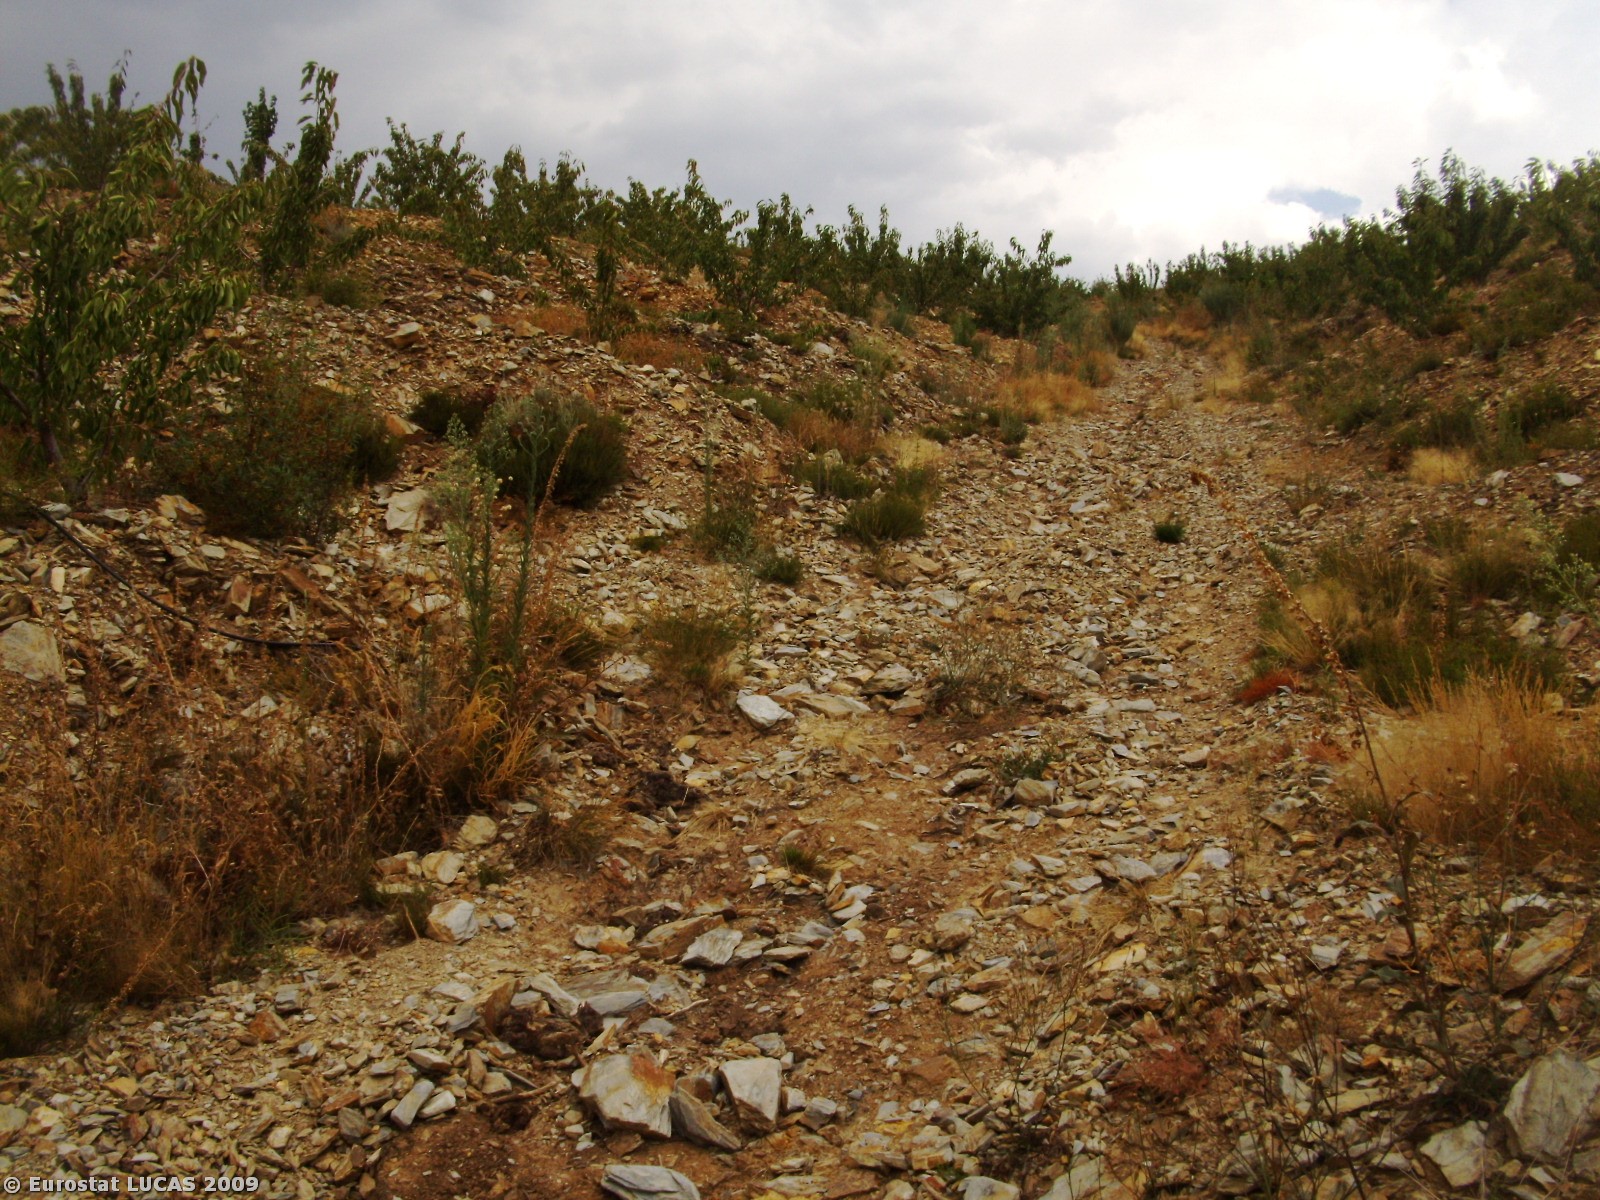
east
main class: Cropland
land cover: Cherry fruit
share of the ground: 25 - 50 %
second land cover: Bare land
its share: > 75 %
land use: Agriculture (excluding fallow land and kitchen gardens)
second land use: Fallow land
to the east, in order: Cherry fruit; Bare land; Tracks; Cherry fruit; Tracks; Cherry fruit; Fences; Tracks; Coniferous woodland
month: August
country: PT
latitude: 40.1027
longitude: -7.5973
